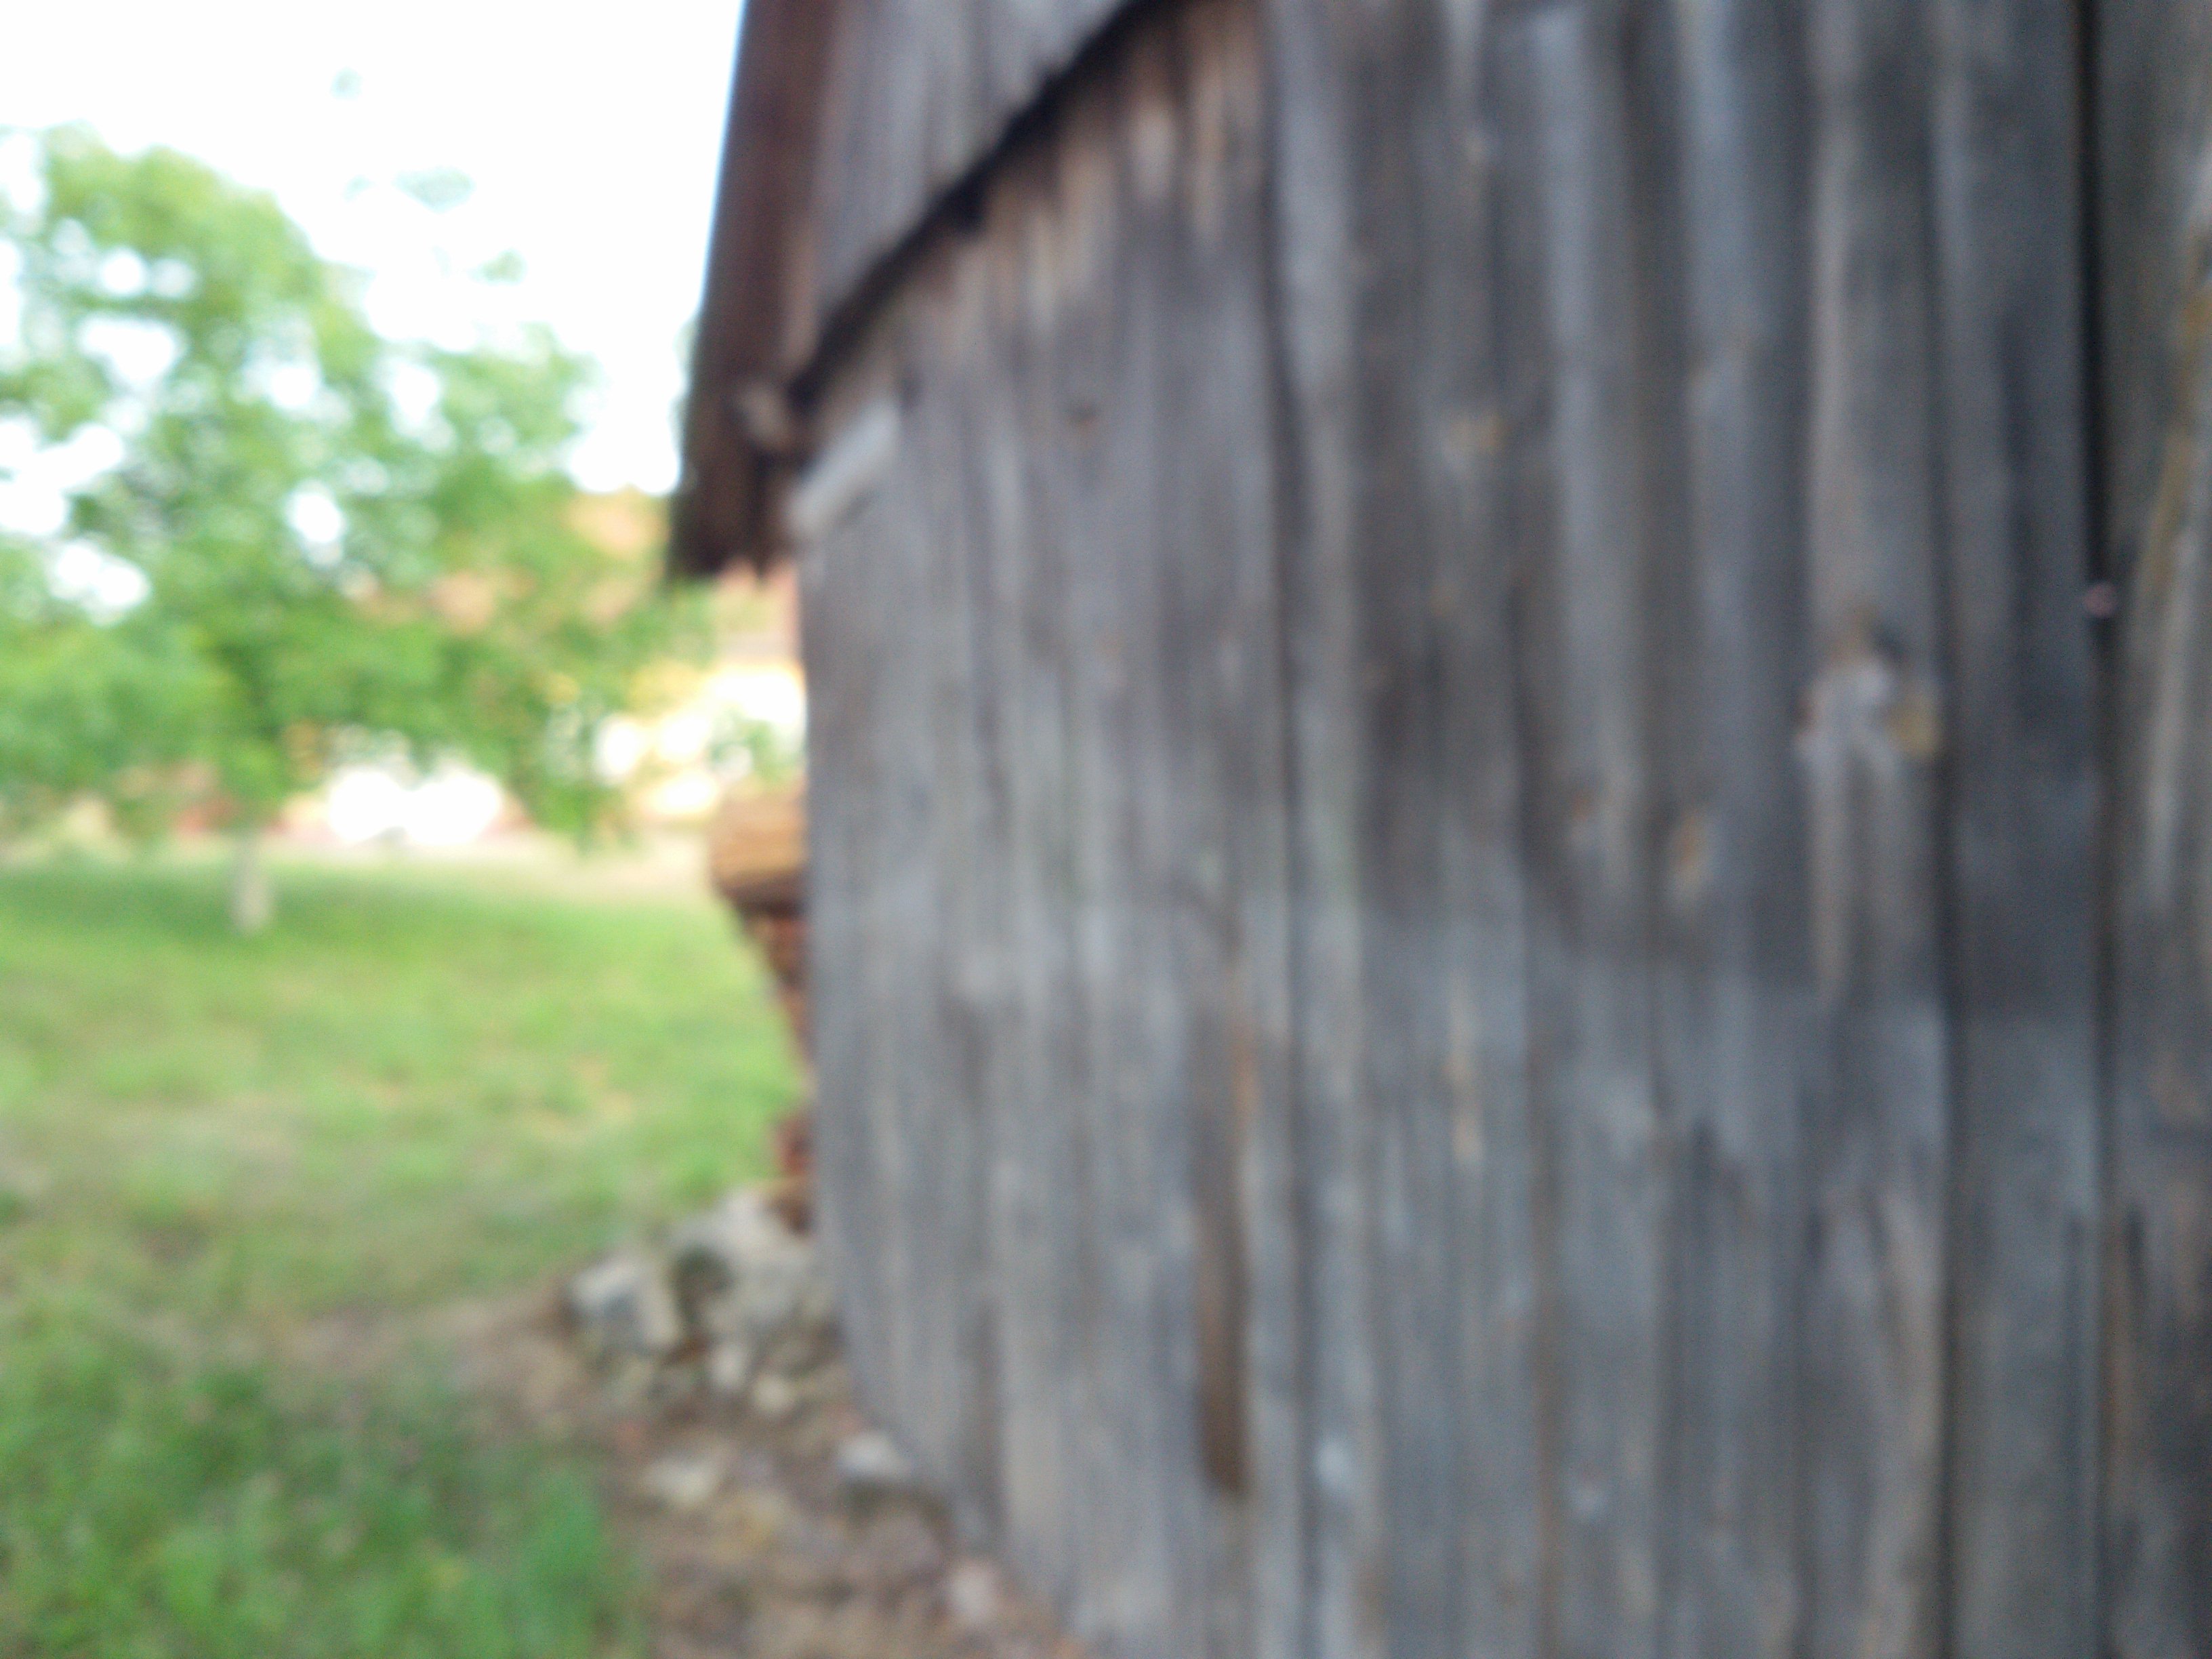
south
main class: Grassland
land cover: Grassland with sparse tree/shrub cover
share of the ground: 50 - 75 %
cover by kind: herbaceous plants 95 %, coniferous forest trees 5 %
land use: Residential
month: July
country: PL
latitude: 50.2158
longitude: 22.3820
